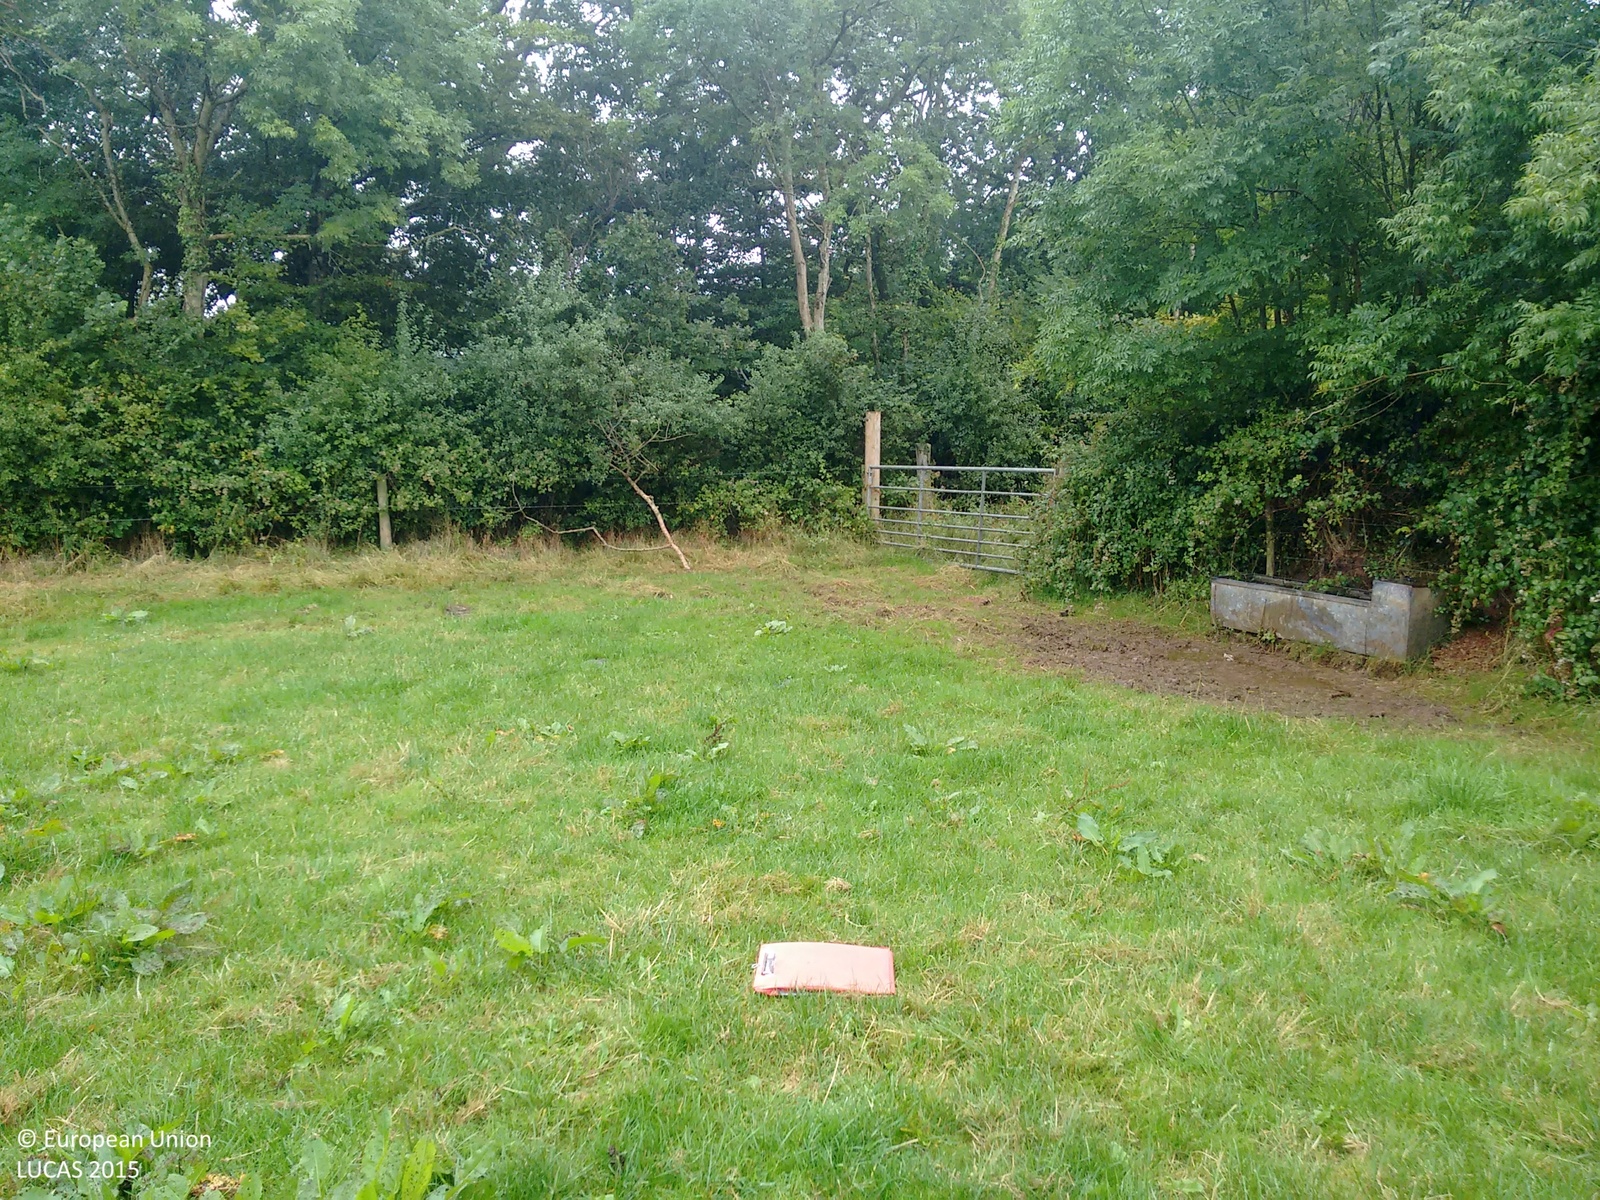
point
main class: Grassland
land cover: Grassland without tree/shrub cover
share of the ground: > 75 %
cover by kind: unconsolidated bare surface 75 %, herbaceous plants 25 %
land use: Agriculture (excluding fallow land and kitchen gardens)
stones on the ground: < 10 %
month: August
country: GB
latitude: 50.9575
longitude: -3.3934
